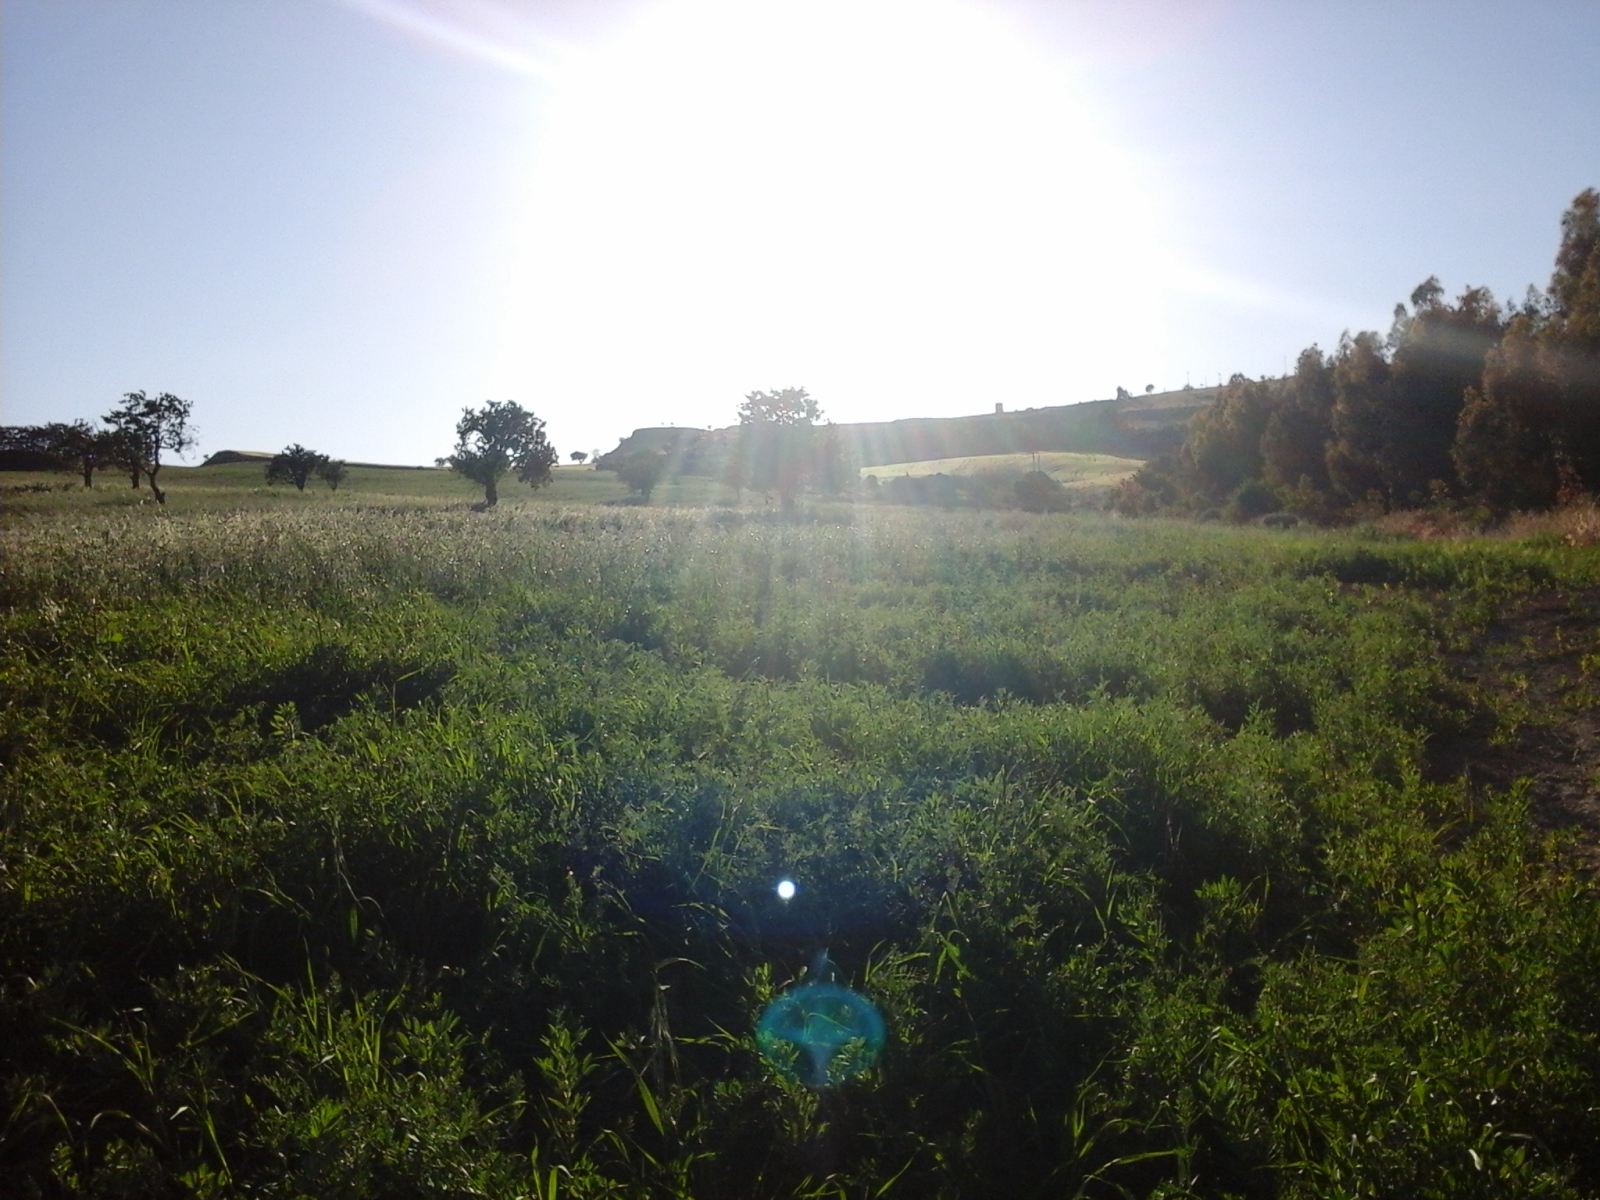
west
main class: Cropland
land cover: Dry pulses
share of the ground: > 75 %
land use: Agriculture (excluding fallow land and kitchen gardens)
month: May
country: IT
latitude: 37.4947
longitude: 14.1203
